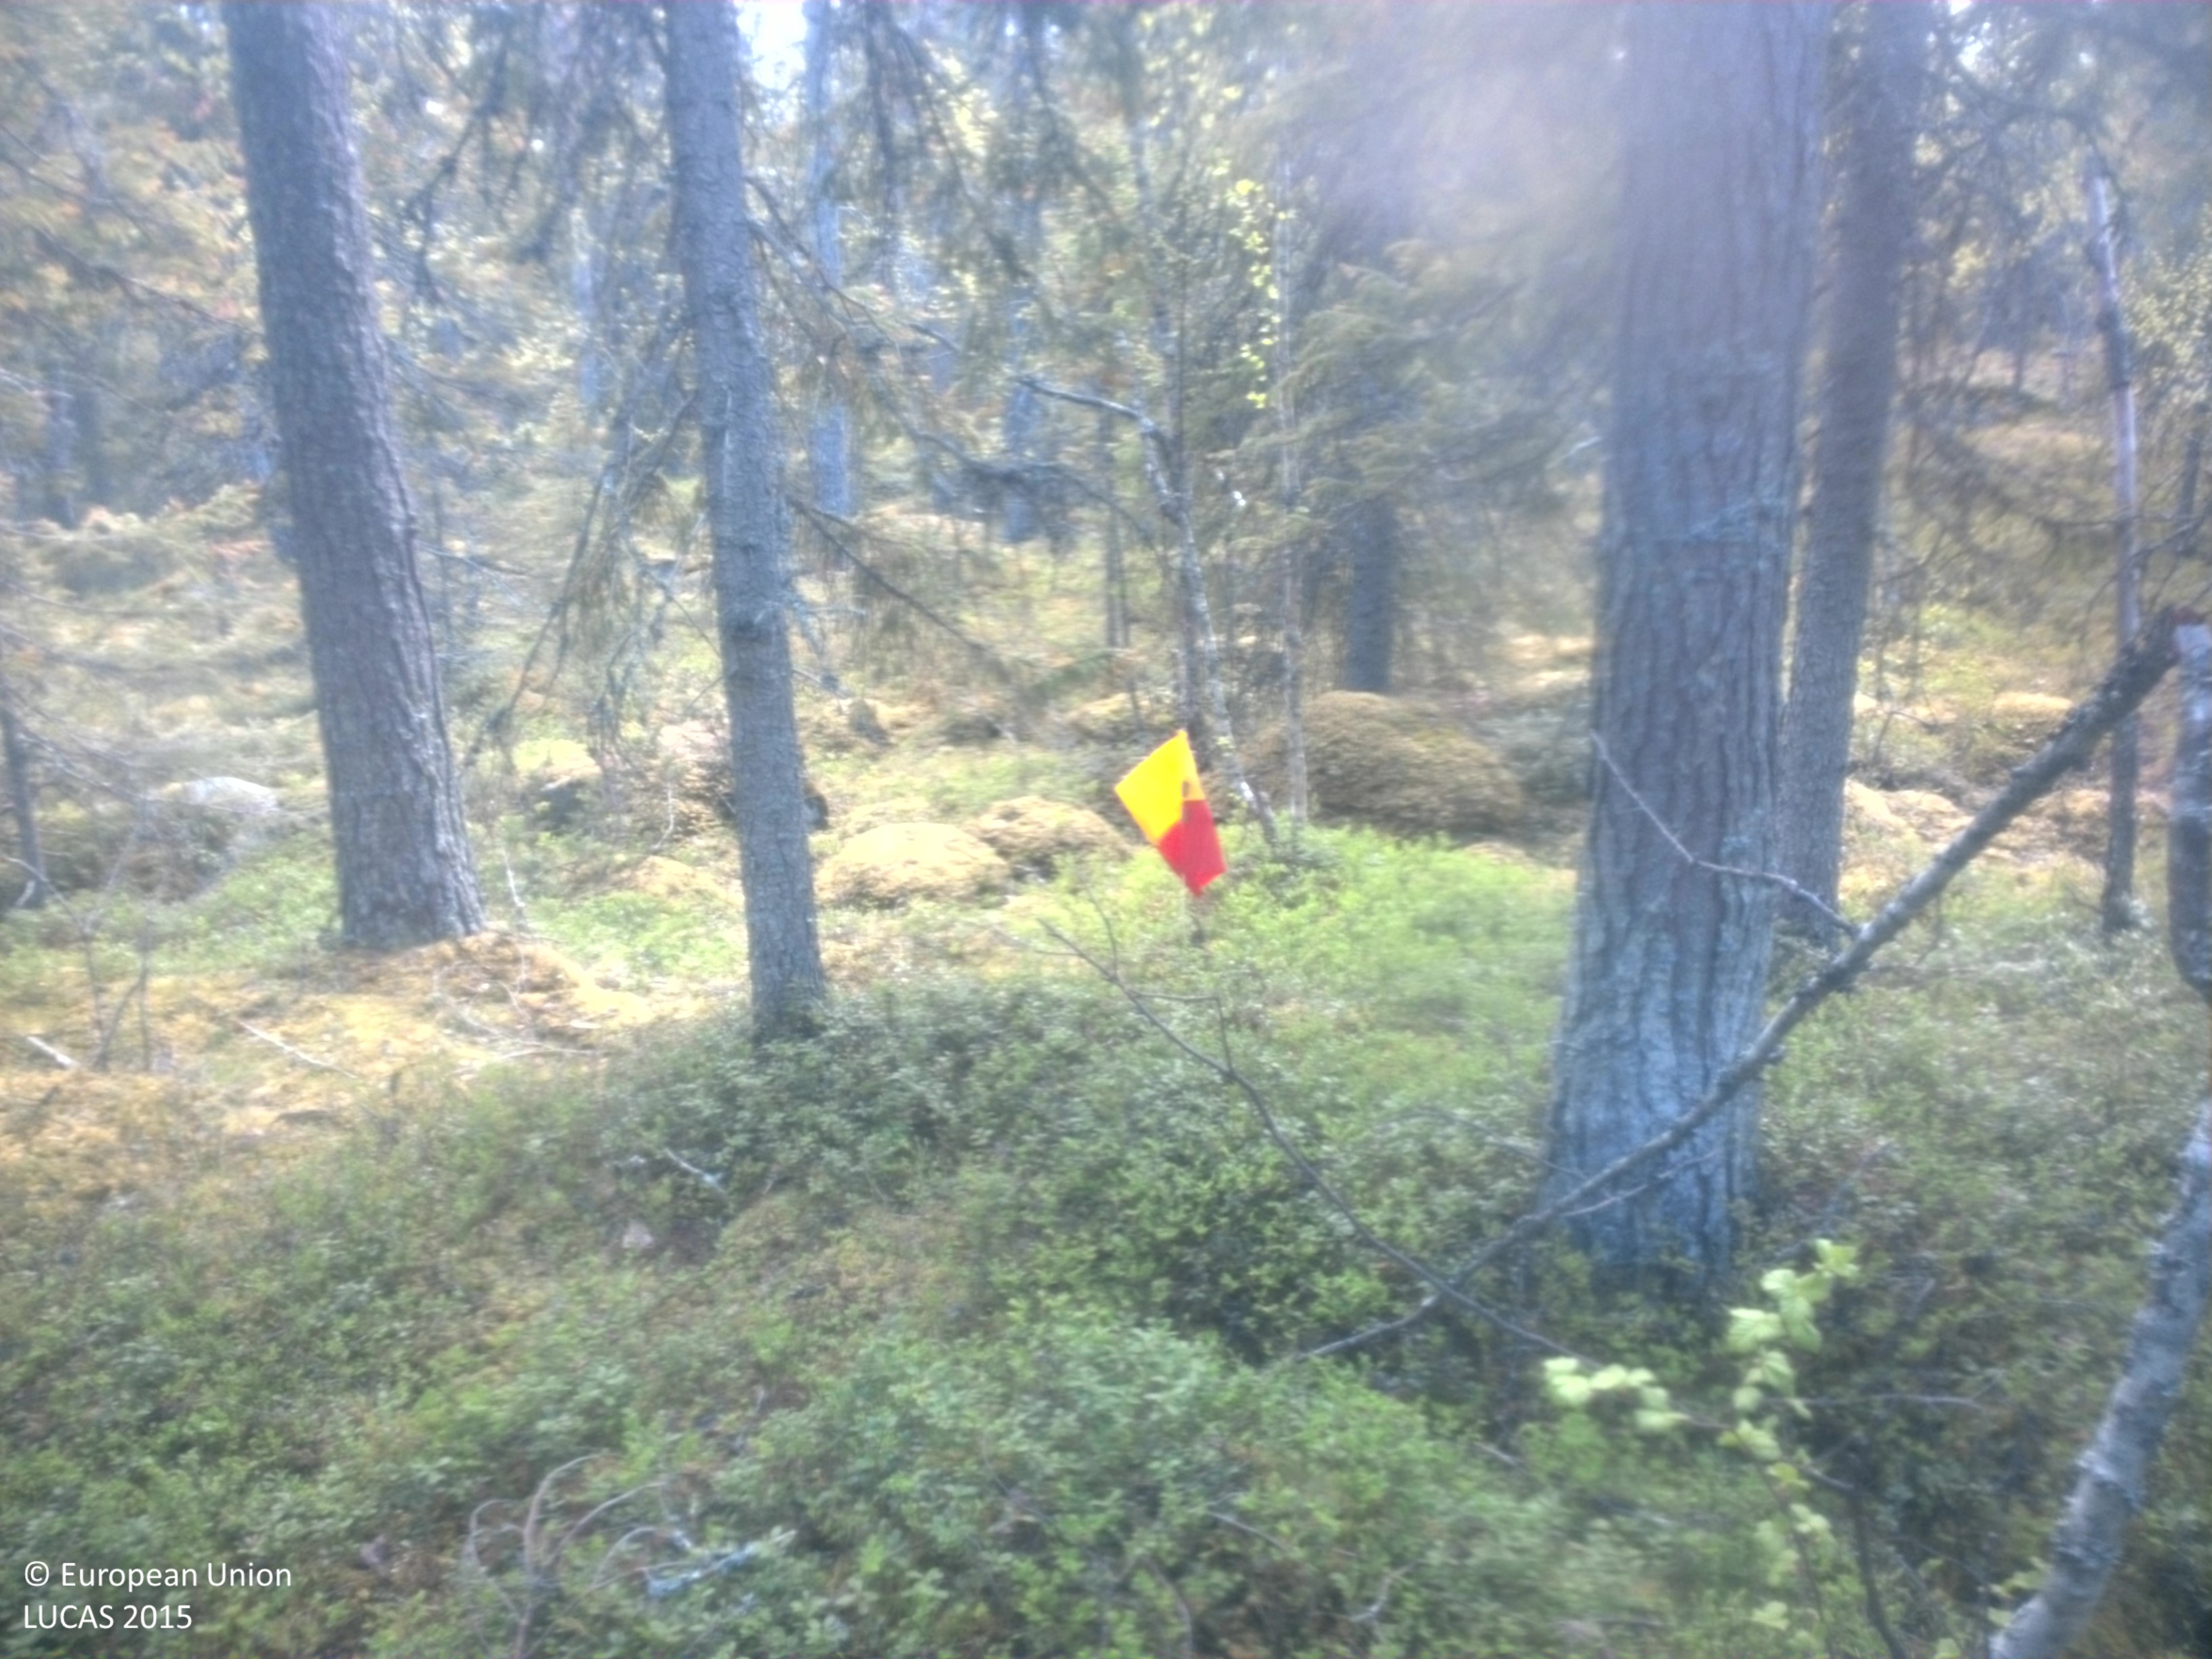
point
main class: Woodland
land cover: Pine dominated coniferous woodland
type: boreal forest
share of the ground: 50 - 75 %
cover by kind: coniferous forest trees 50 %, herbaceous plants 25 %, lichens and mosses 10 %, broadleaved forest trees 5 %, shrubs 5 %, unconsolidated bare surface 5 %
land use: Forestry
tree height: > 5 m
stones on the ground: 25 - 50 %
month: June
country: SE
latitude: 64.3368
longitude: 17.7292
